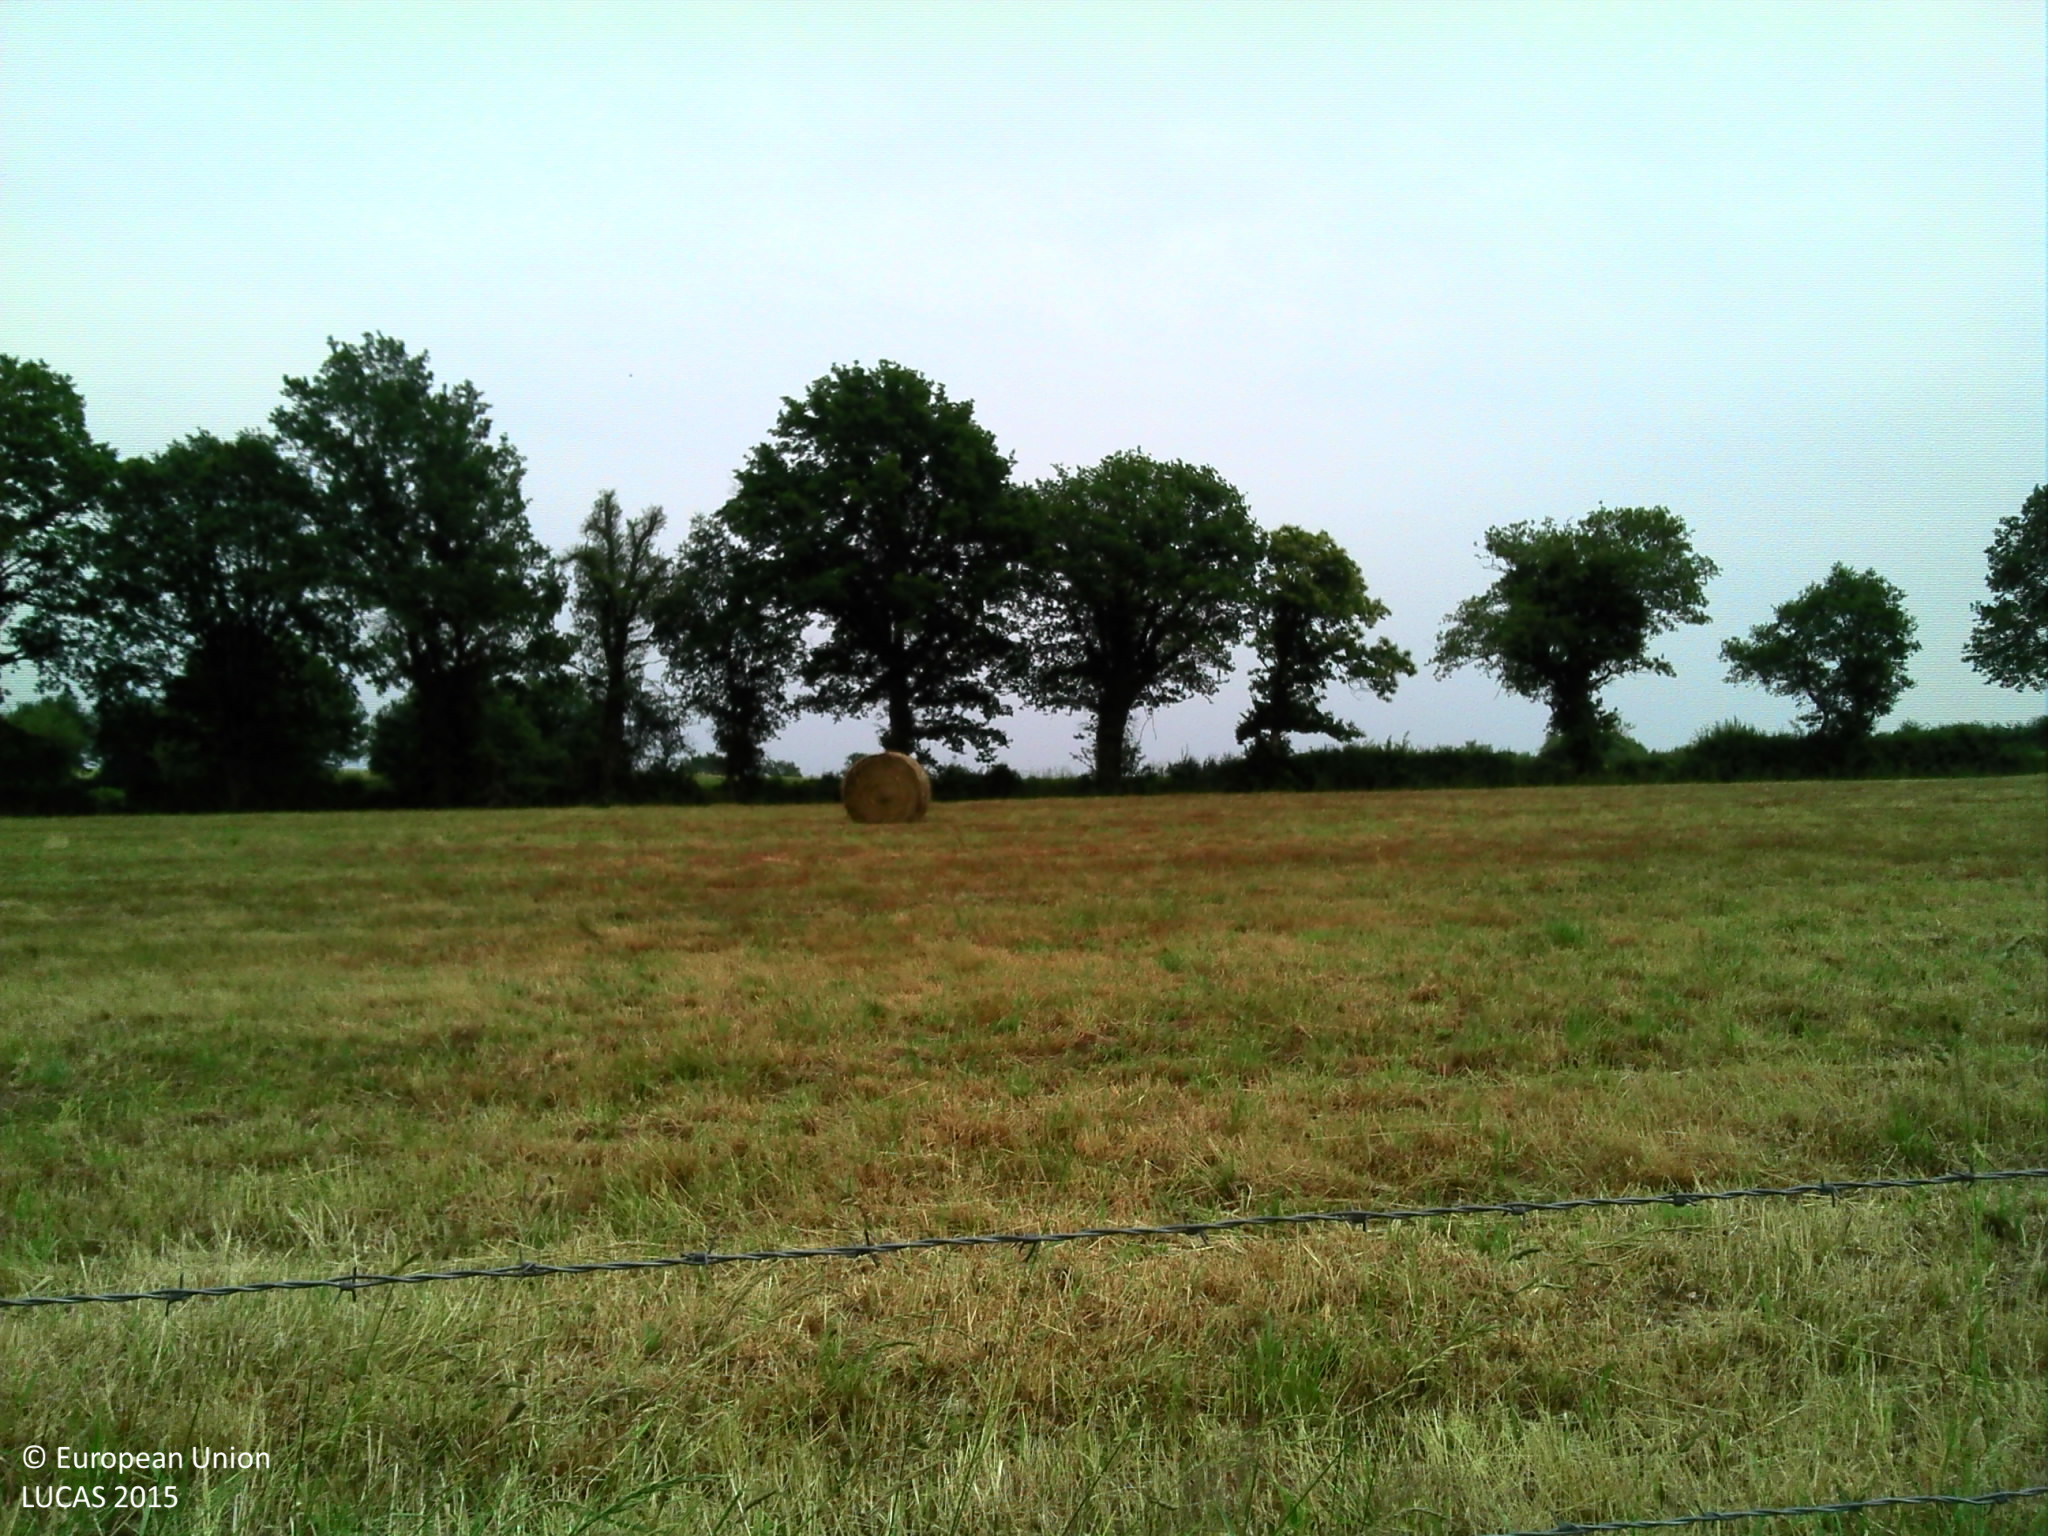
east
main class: Grassland
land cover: Grassland without tree/shrub cover
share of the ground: > 75 %
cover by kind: herbaceous plants 100 %
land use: Agriculture (excluding fallow land and kitchen gardens)
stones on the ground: < 10 %
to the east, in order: Grassland without tree/shrub cover; Fences; Grassland without tree/shrub cover; Lines of trees; Fences; Lucerne
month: June
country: FR
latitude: 46.6112
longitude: 2.7492
